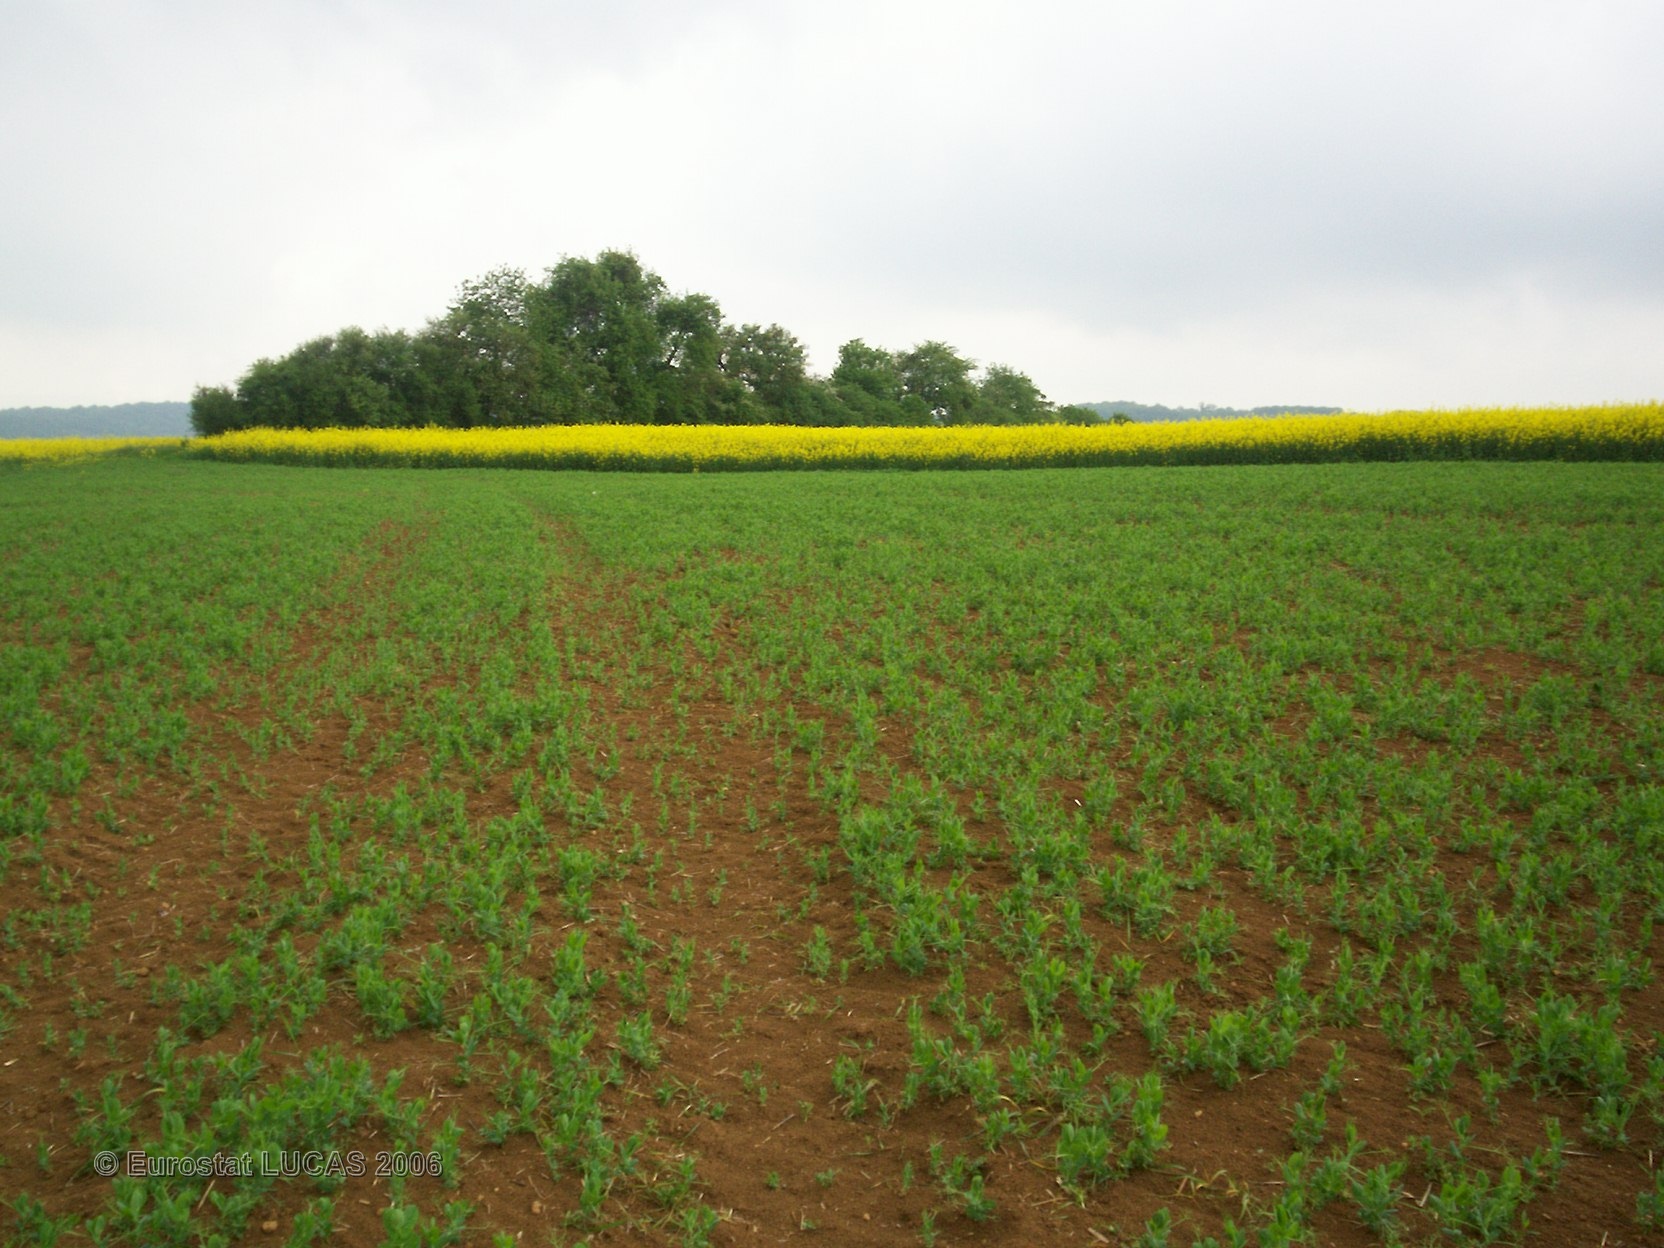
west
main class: Cropland
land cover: Dry pulses
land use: Agriculture (excluding fallow land and kitchen gardens)
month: May
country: FR
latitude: 49.4254
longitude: 6.4014
